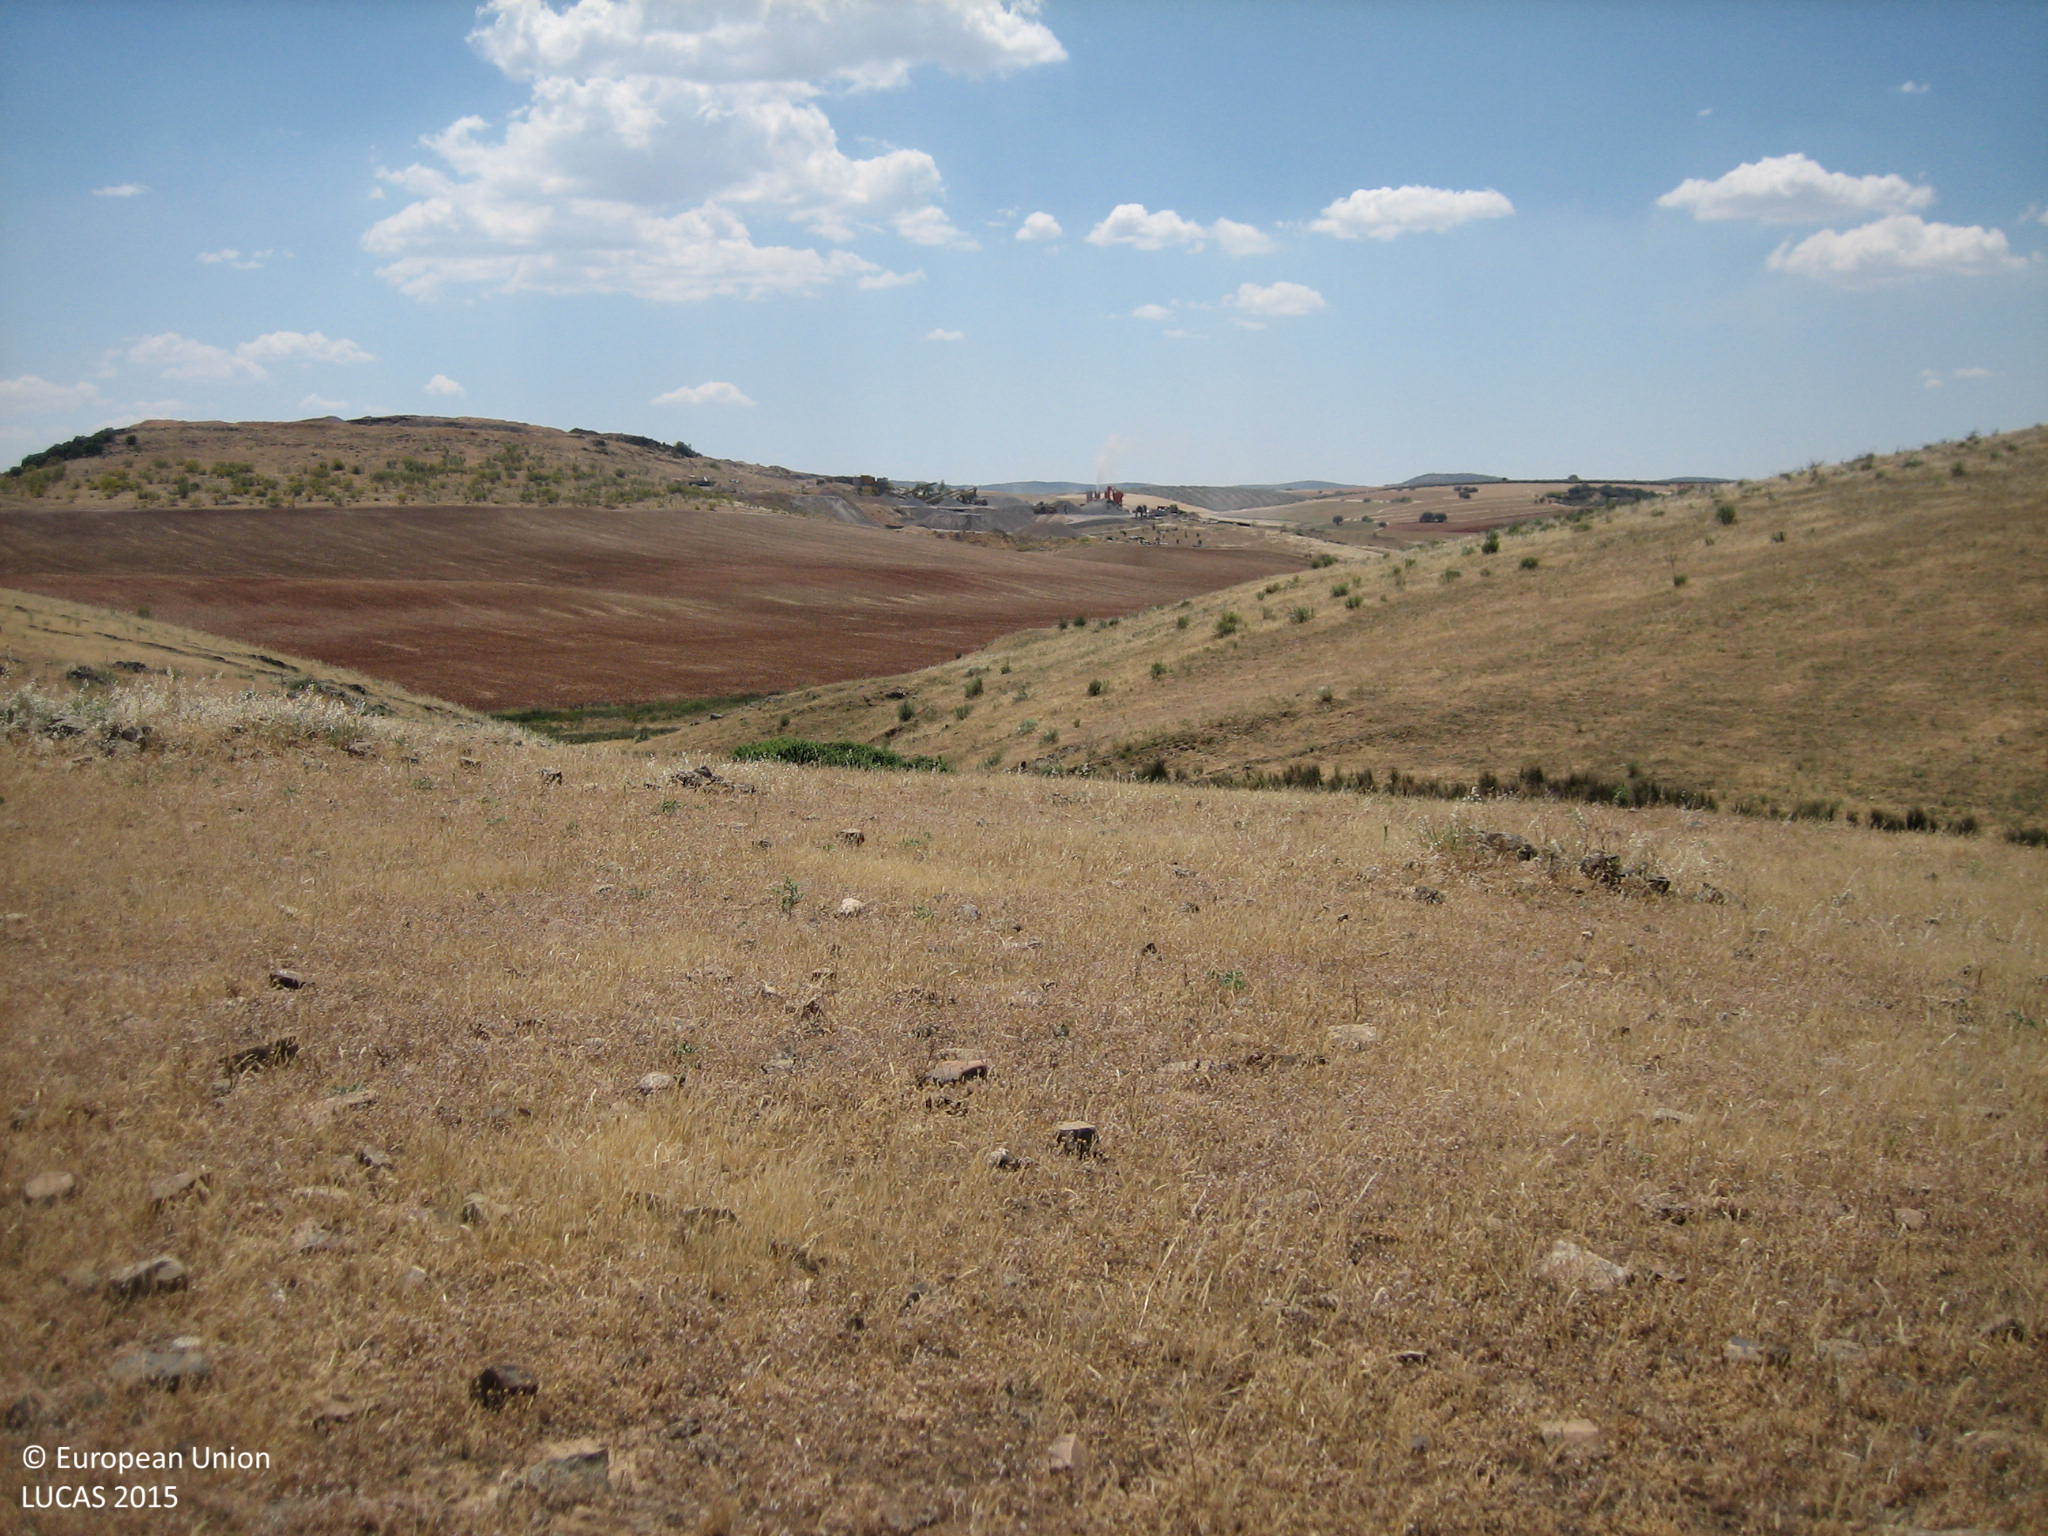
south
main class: Grassland
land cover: Grassland without tree/shrub cover
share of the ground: > 75 %
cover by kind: herbaceous plants 100 %
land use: Agriculture (excluding fallow land and kitchen gardens)
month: May
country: ES
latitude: 38.9017
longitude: -4.0538
